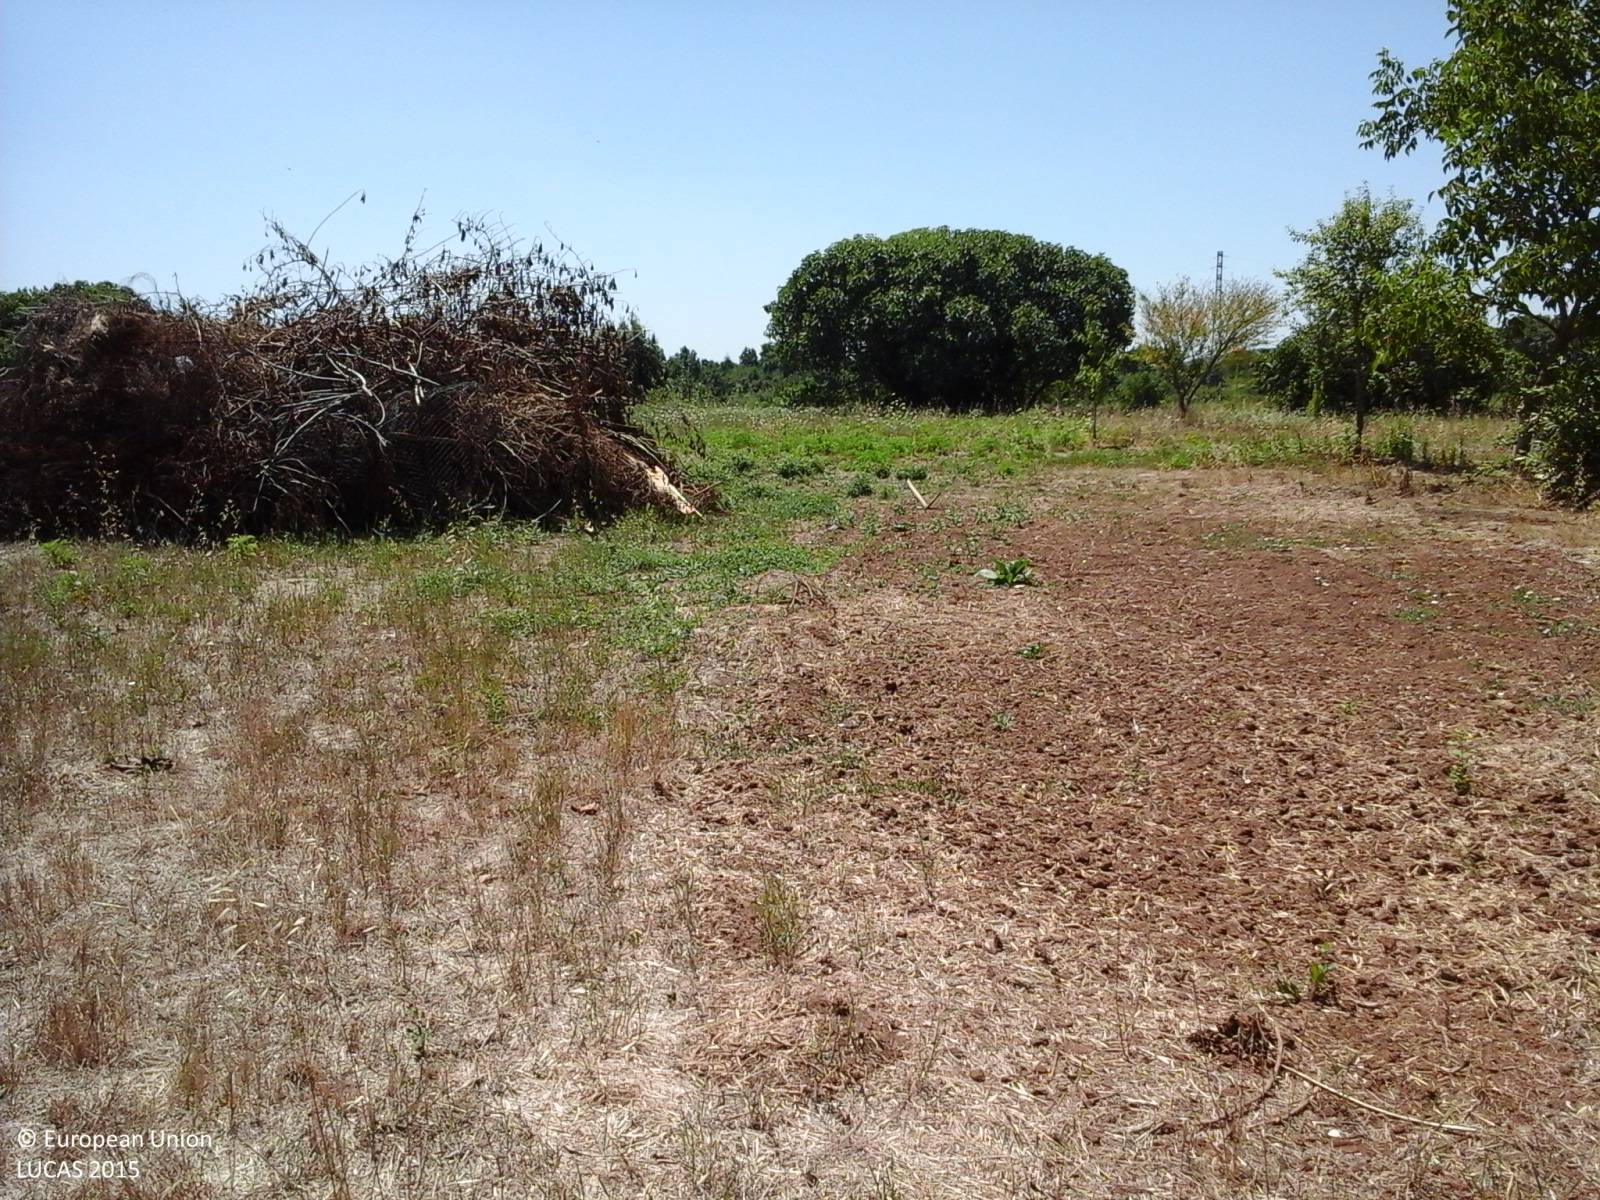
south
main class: Grassland
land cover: Grassland with sparse tree/shrub cover
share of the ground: > 75 %
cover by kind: herbaceous plants 95 %, broadleaved forest trees 5 %
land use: Abandoned areas
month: July
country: IT
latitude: 42.2477
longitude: 12.3310
